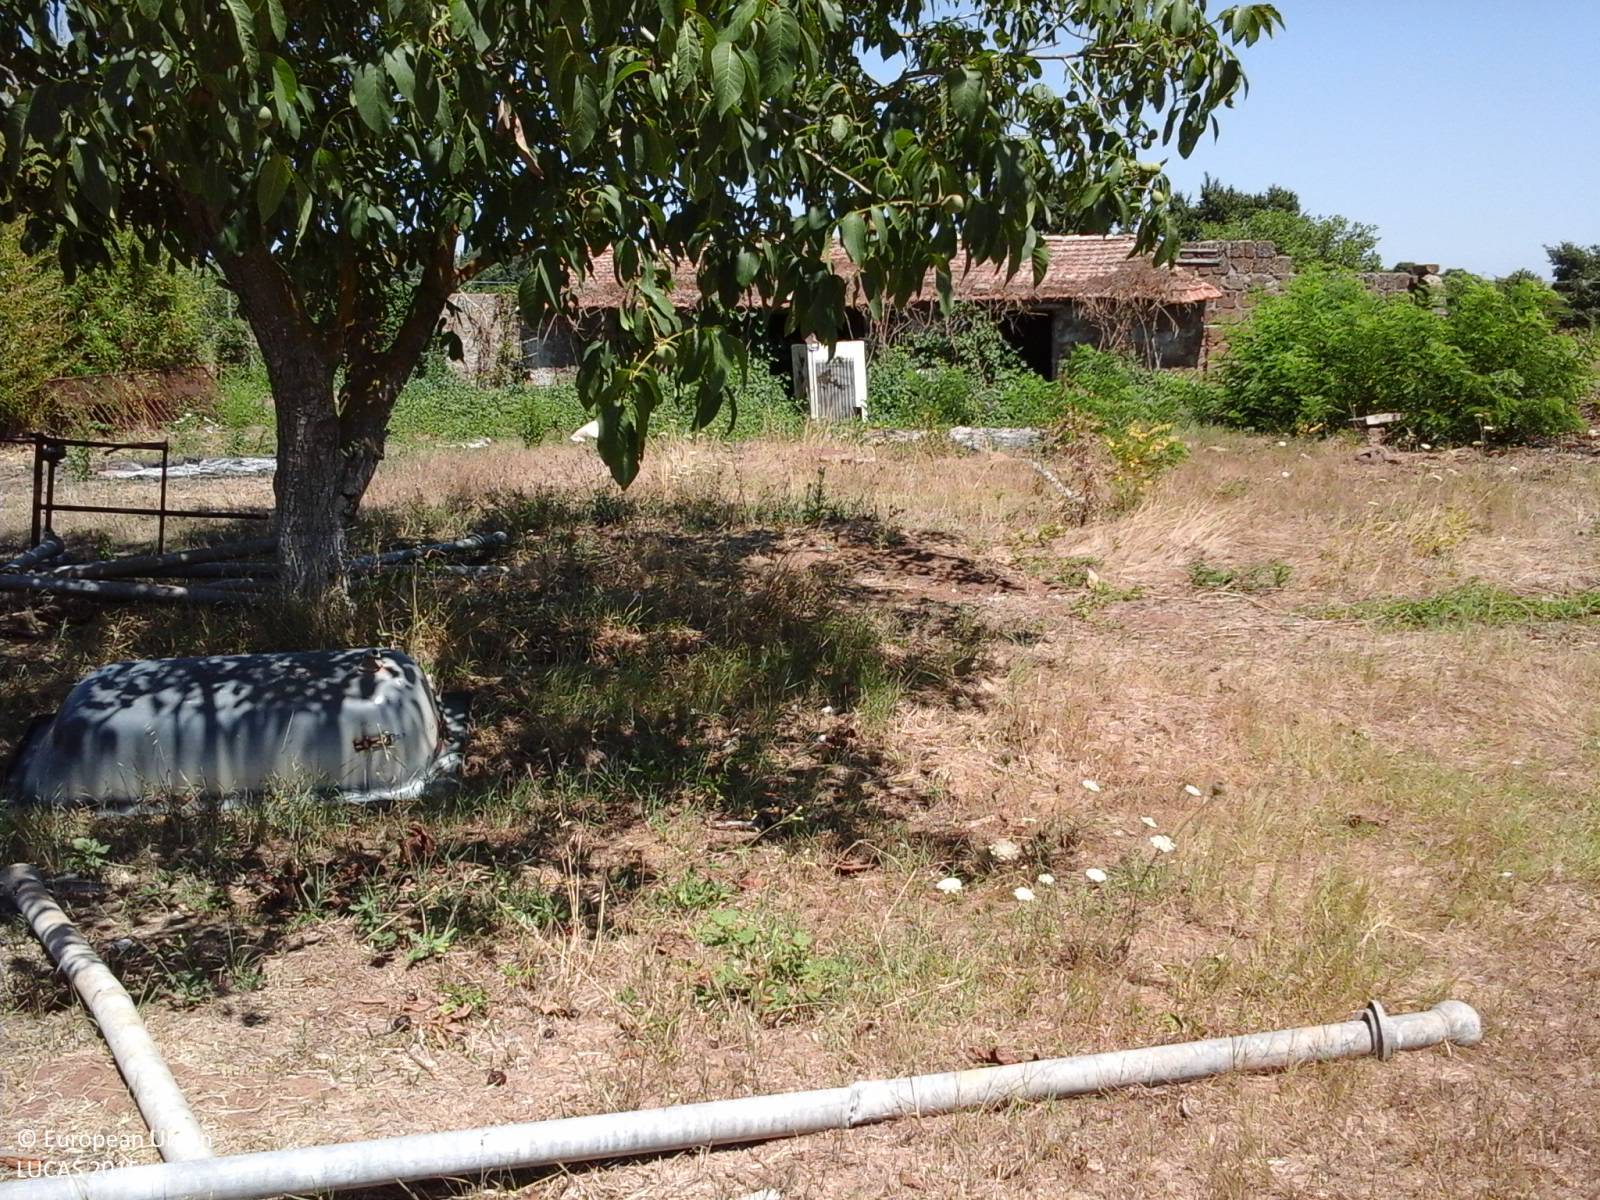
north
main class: Grassland
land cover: Grassland with sparse tree/shrub cover
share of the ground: > 75 %
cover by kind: herbaceous plants 95 %, broadleaved forest trees 5 %
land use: Abandoned areas
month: July
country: IT
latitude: 42.2477
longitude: 12.3310
